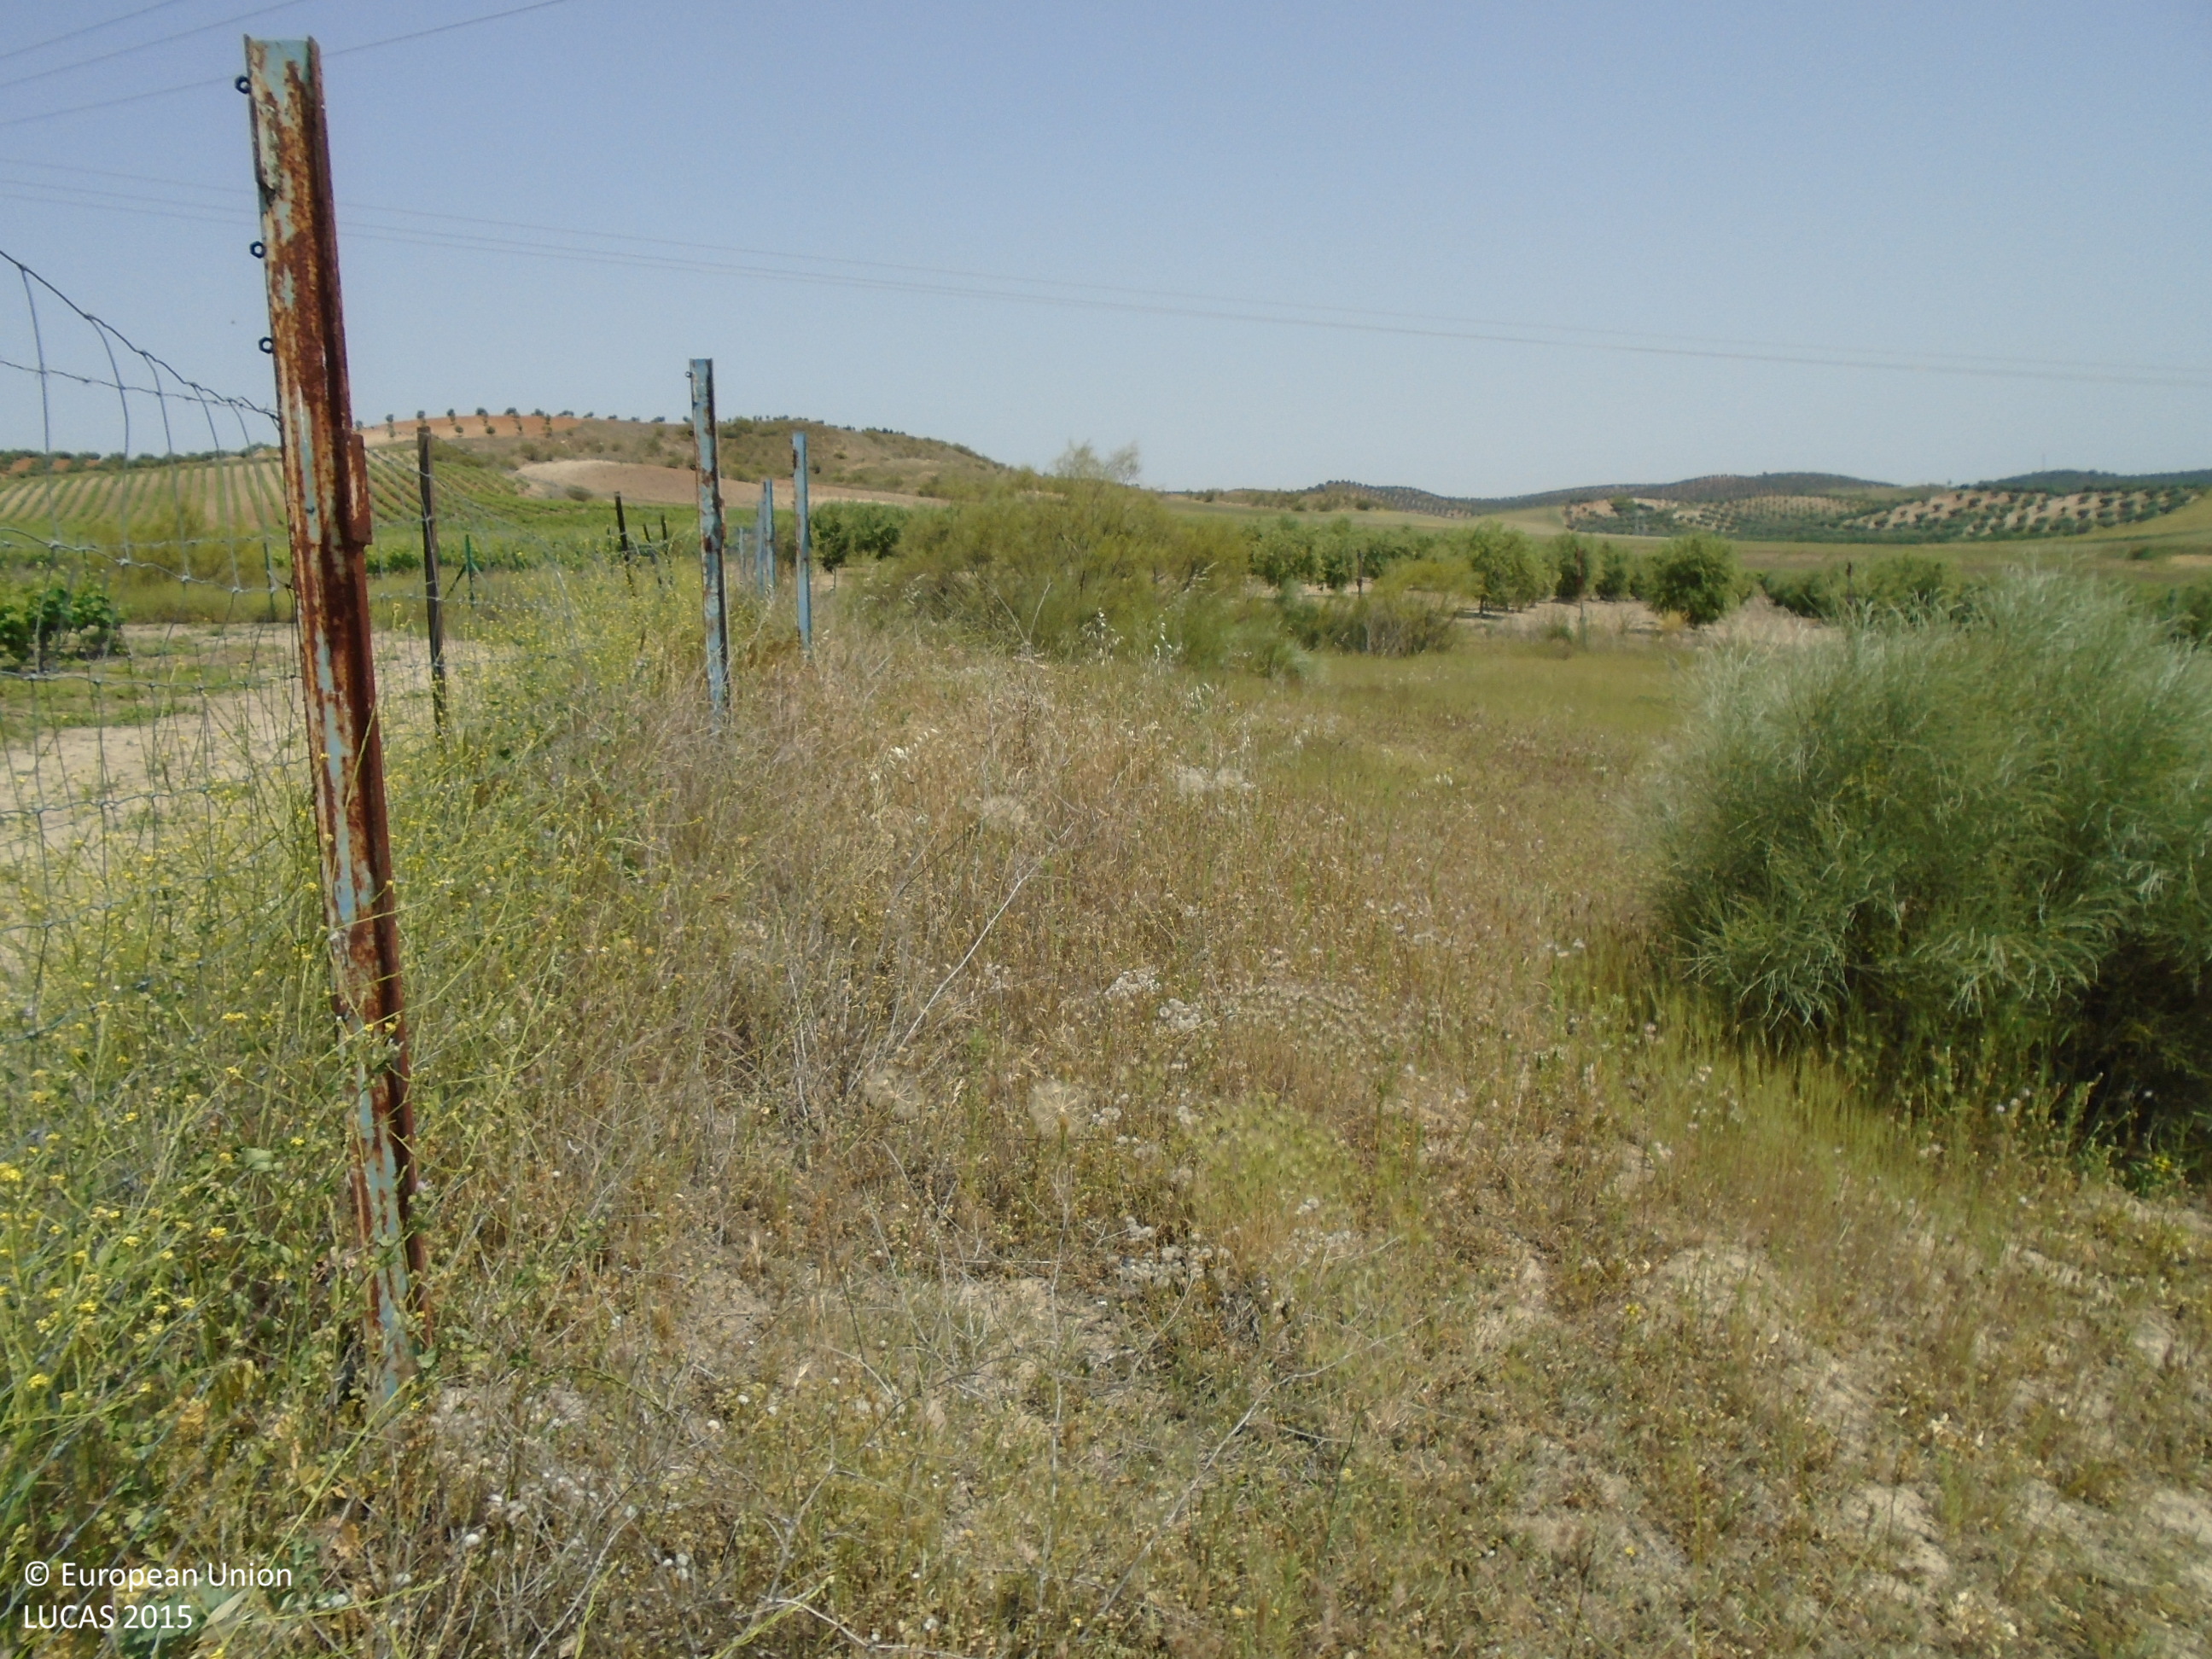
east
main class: Cropland
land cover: Vineyards
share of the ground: 10 - 25 %
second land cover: Other bare soil
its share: > 75 %
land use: Agriculture (excluding fallow land and kitchen gardens)
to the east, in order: Vineyards; Other bare soil; Tracks; Fences; Grass margins; Tracks; Grass margins; Fences; Grass margins; Electric lines; Olive groves; Grass margins; Tracks; Grass margins; Vineyards
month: May
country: ES
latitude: 39.7885
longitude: -4.6270
